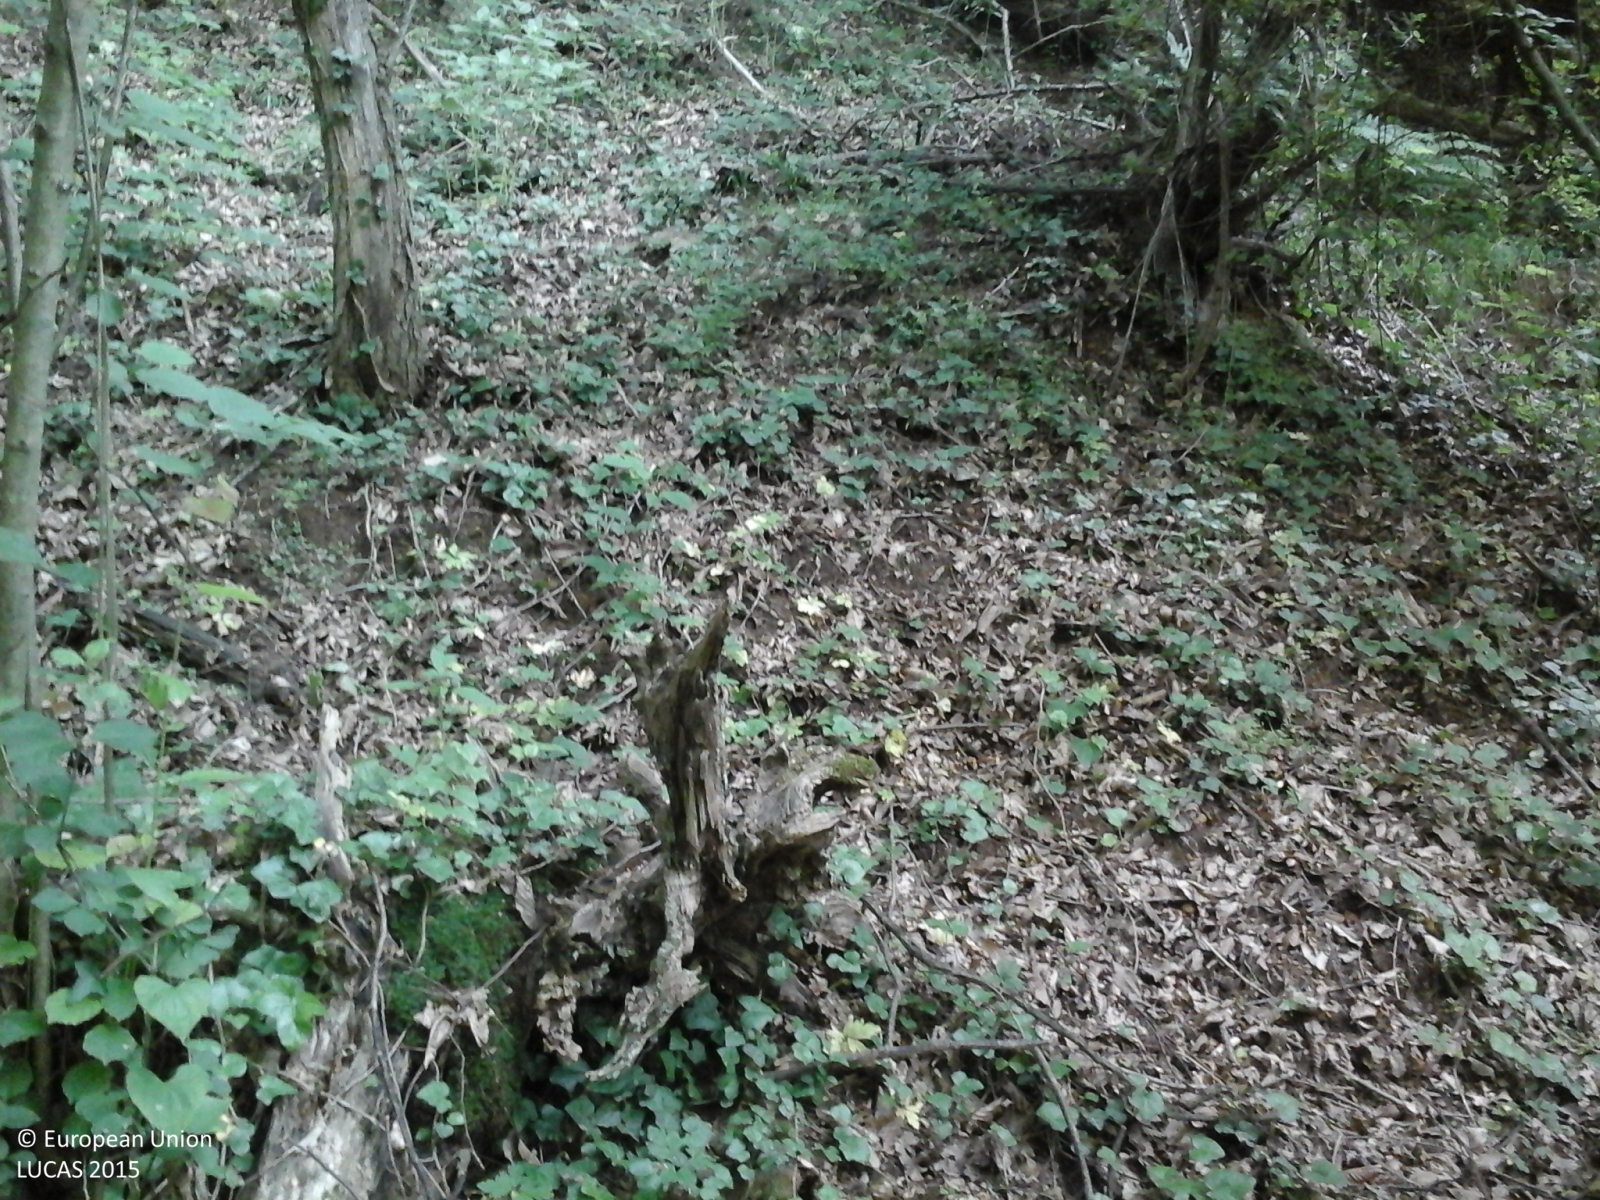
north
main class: Woodland
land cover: Broadleaved woodland
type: mesophytic deciduous forest
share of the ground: > 75 %
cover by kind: broadleaved forest trees 100 %
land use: Forestry
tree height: > 5 m
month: May
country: IT
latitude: 45.5615
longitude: 8.2220
